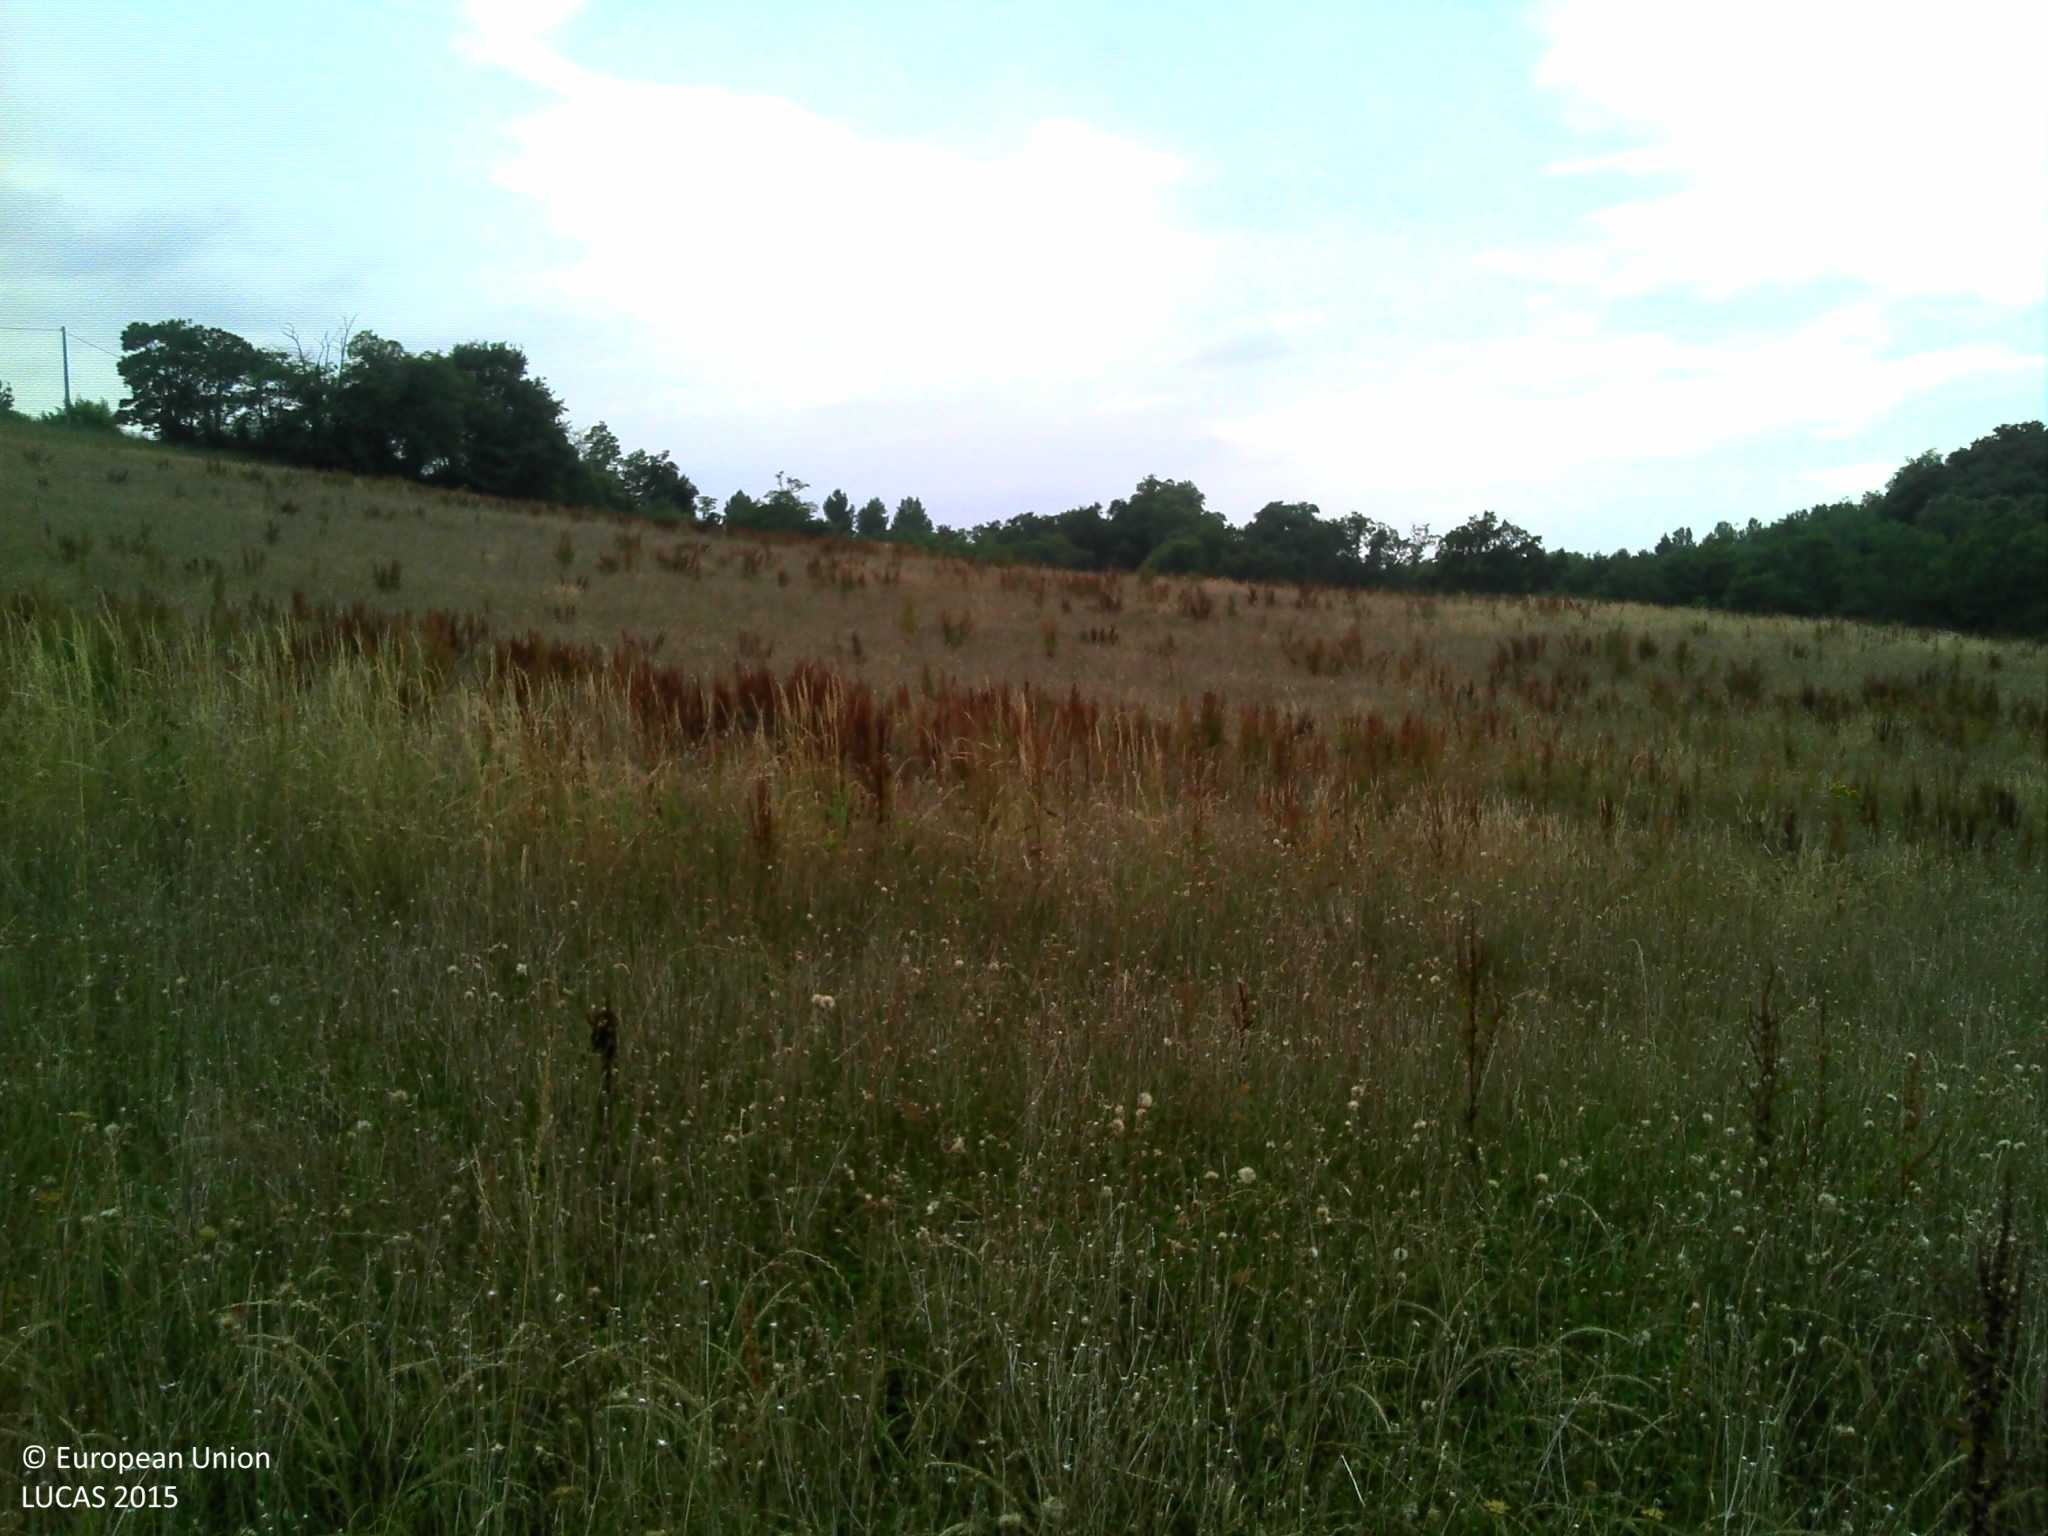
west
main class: Grassland
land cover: Grassland without tree/shrub cover
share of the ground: > 75 %
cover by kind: herbaceous plants 100 %
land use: Agriculture (excluding fallow land and kitchen gardens)
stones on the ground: < 10 %
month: July
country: FR
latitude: 43.6796
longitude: -0.7673
